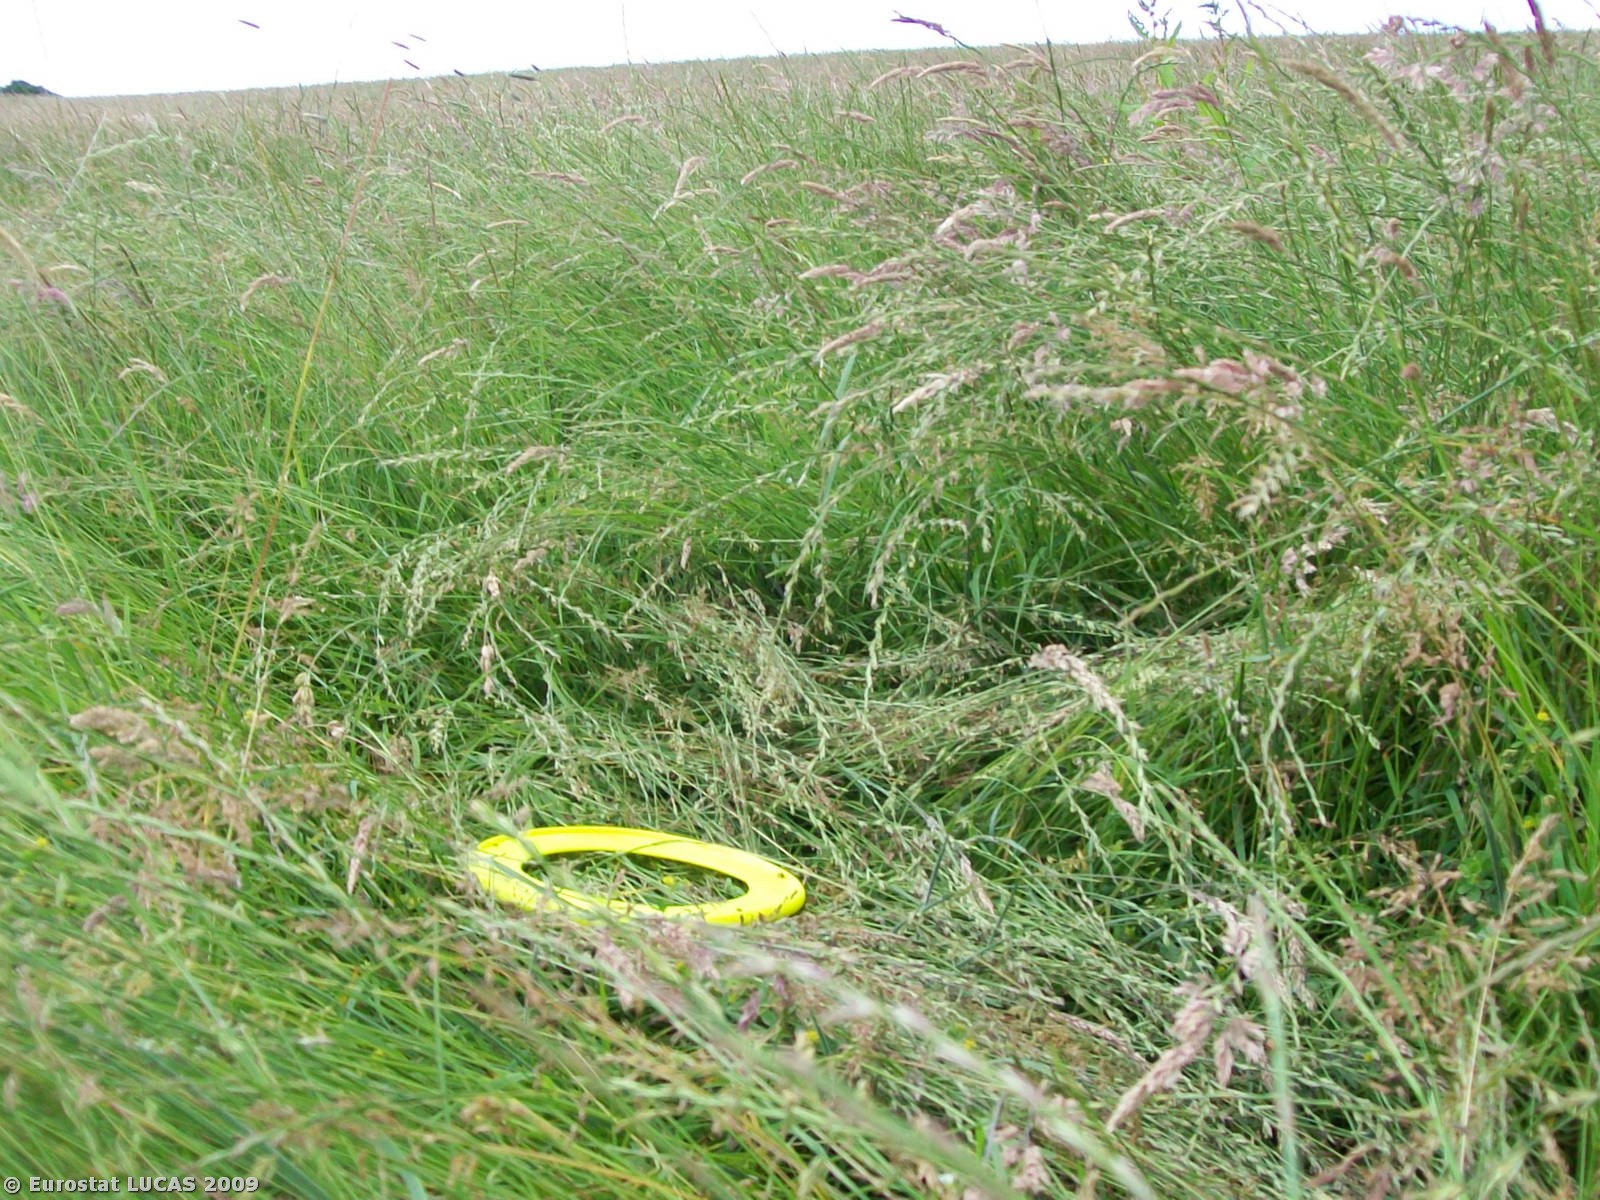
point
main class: Grassland
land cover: Grassland without tree/shrub cover
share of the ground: > 75 %
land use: Agriculture (excluding fallow land and kitchen gardens)
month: July
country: GB
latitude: 54.4715
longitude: -1.8581
